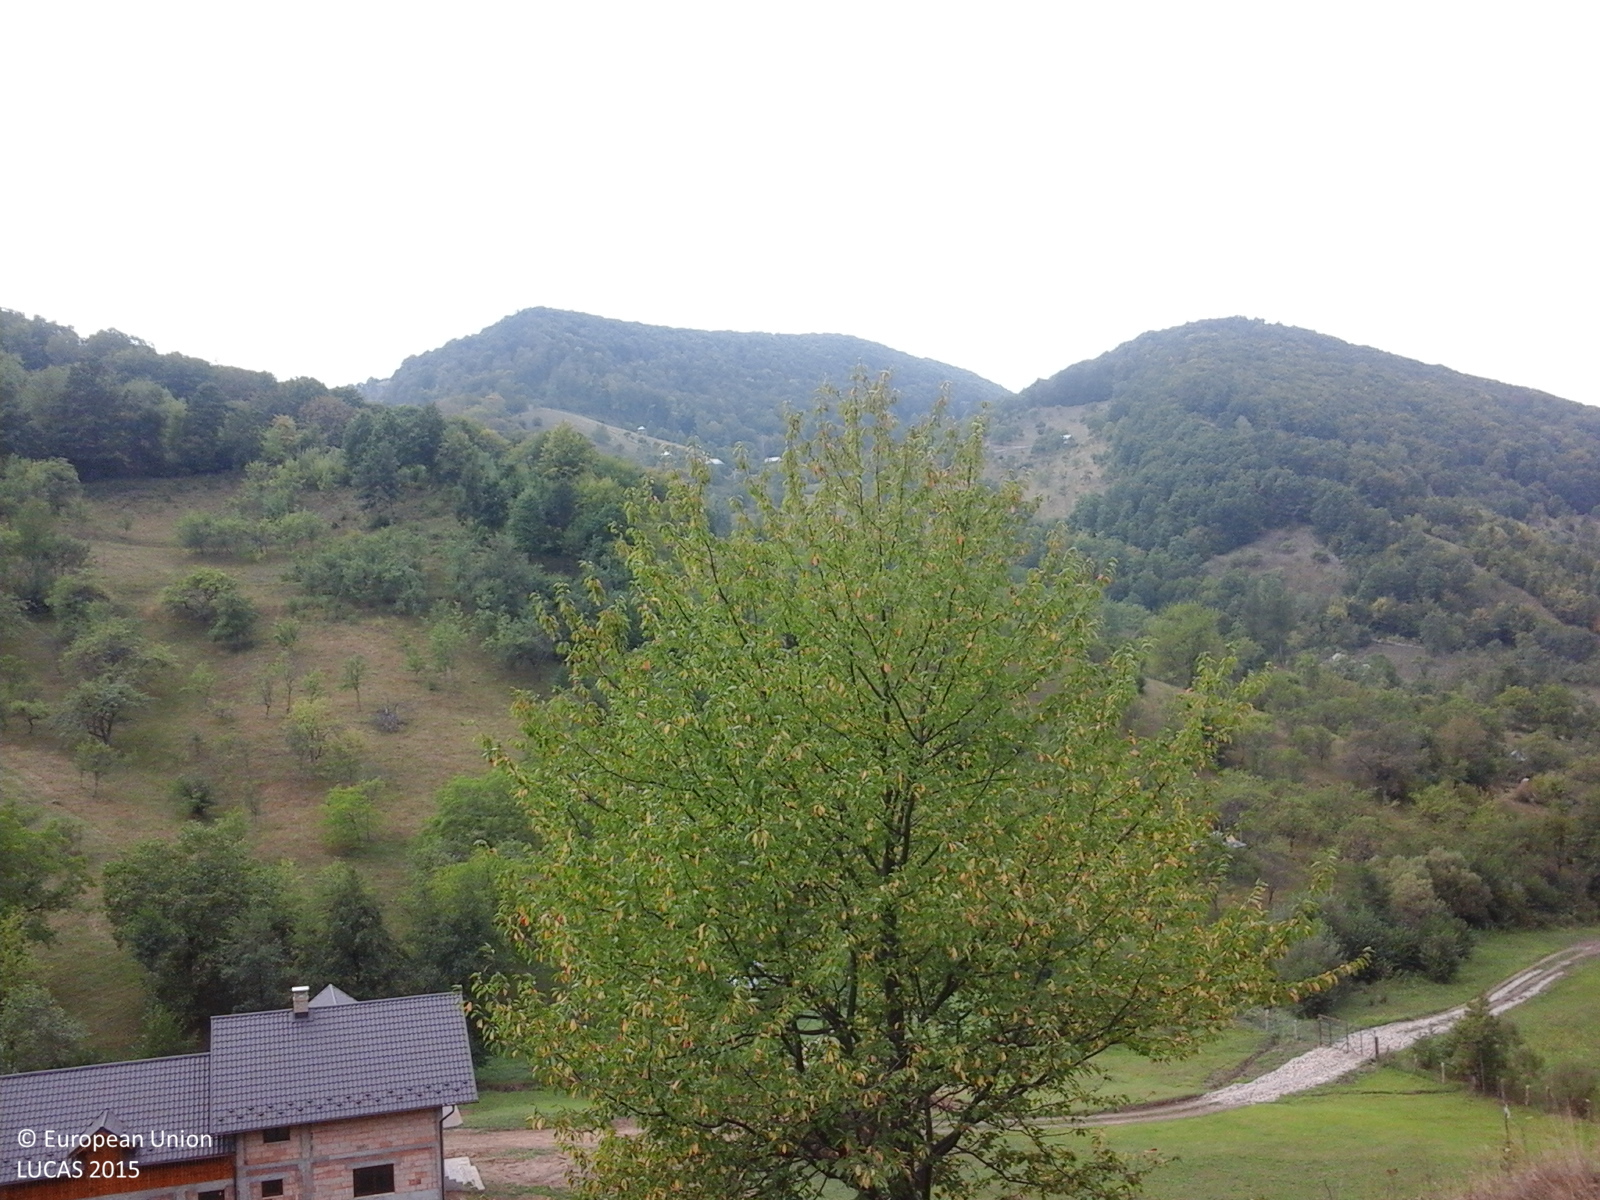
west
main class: Grassland
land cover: Grassland with sparse tree/shrub cover
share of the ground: > 75 %
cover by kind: herbaceous plants 90 %, broadleaved forest trees 5 %, shrubs 5 %
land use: Fallow land
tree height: > 5 m
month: September
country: RO
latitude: 47.8896
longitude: 24.0083
